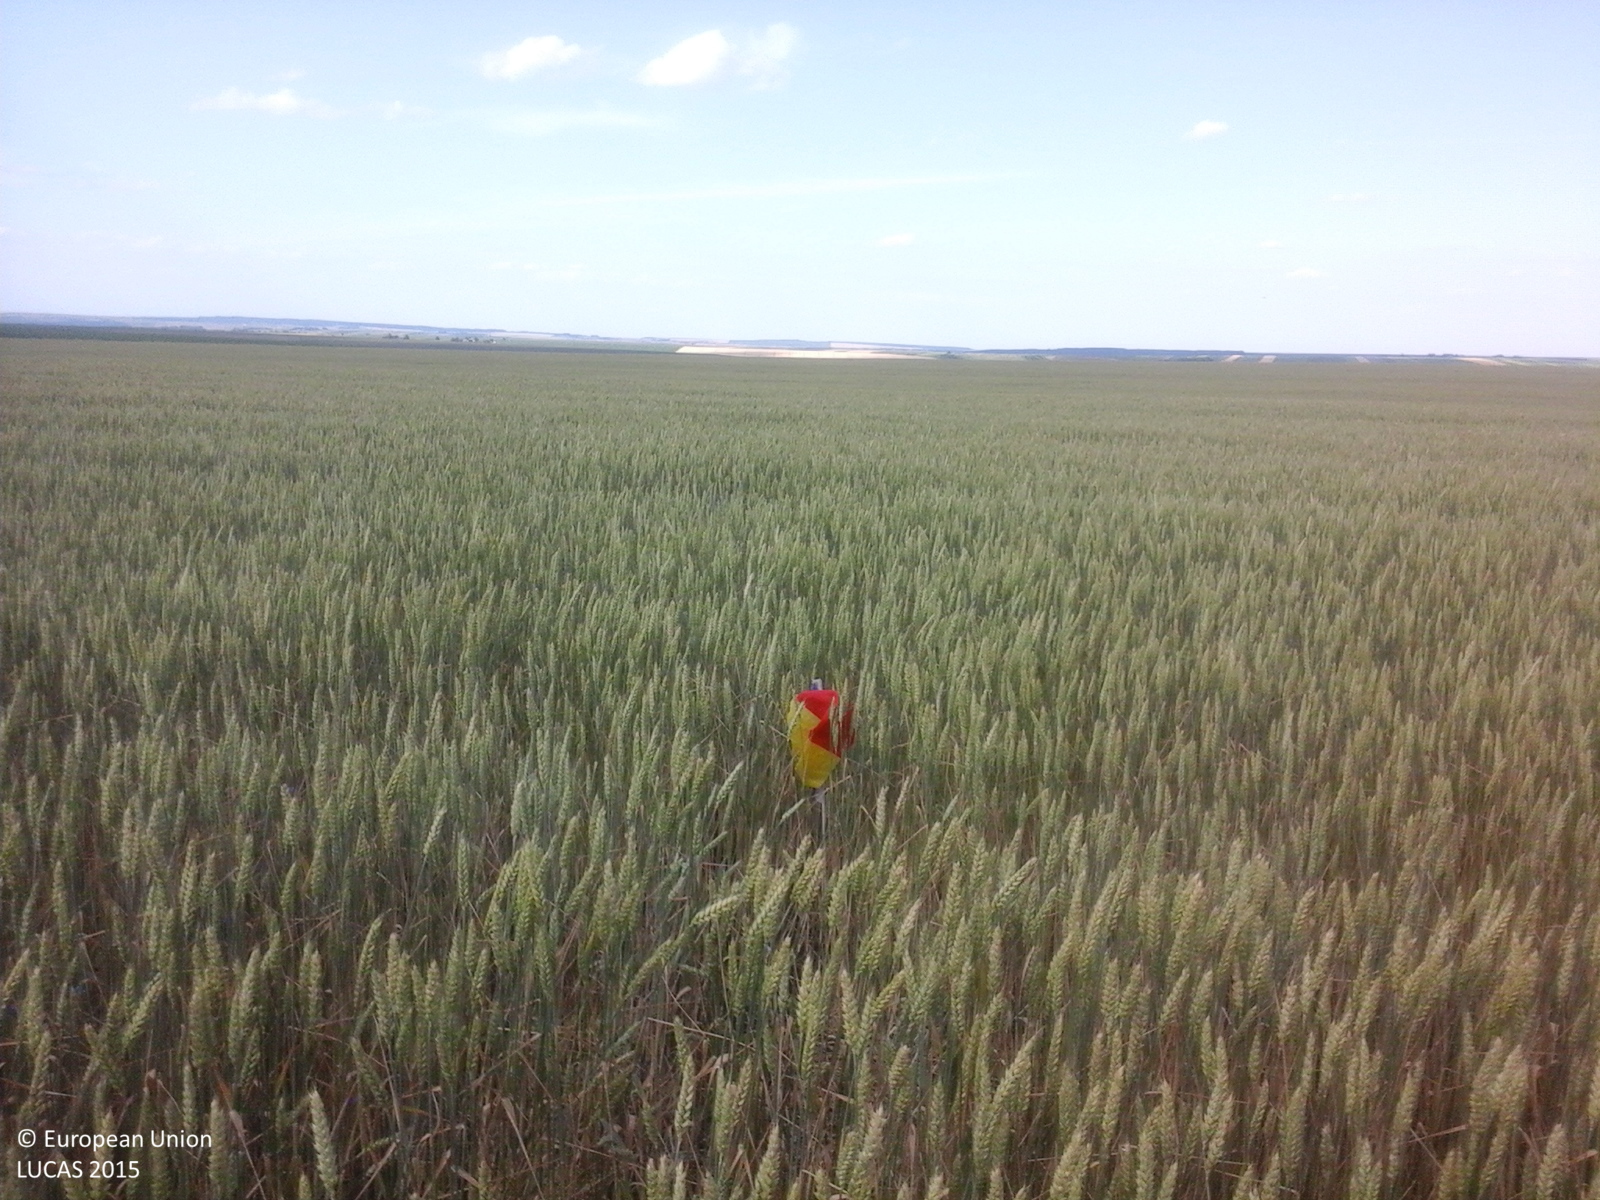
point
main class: Cropland
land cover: Common wheat
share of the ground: > 75 %
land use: Agriculture (excluding fallow land and kitchen gardens)
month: June
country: RO
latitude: 47.8869
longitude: 26.5006
